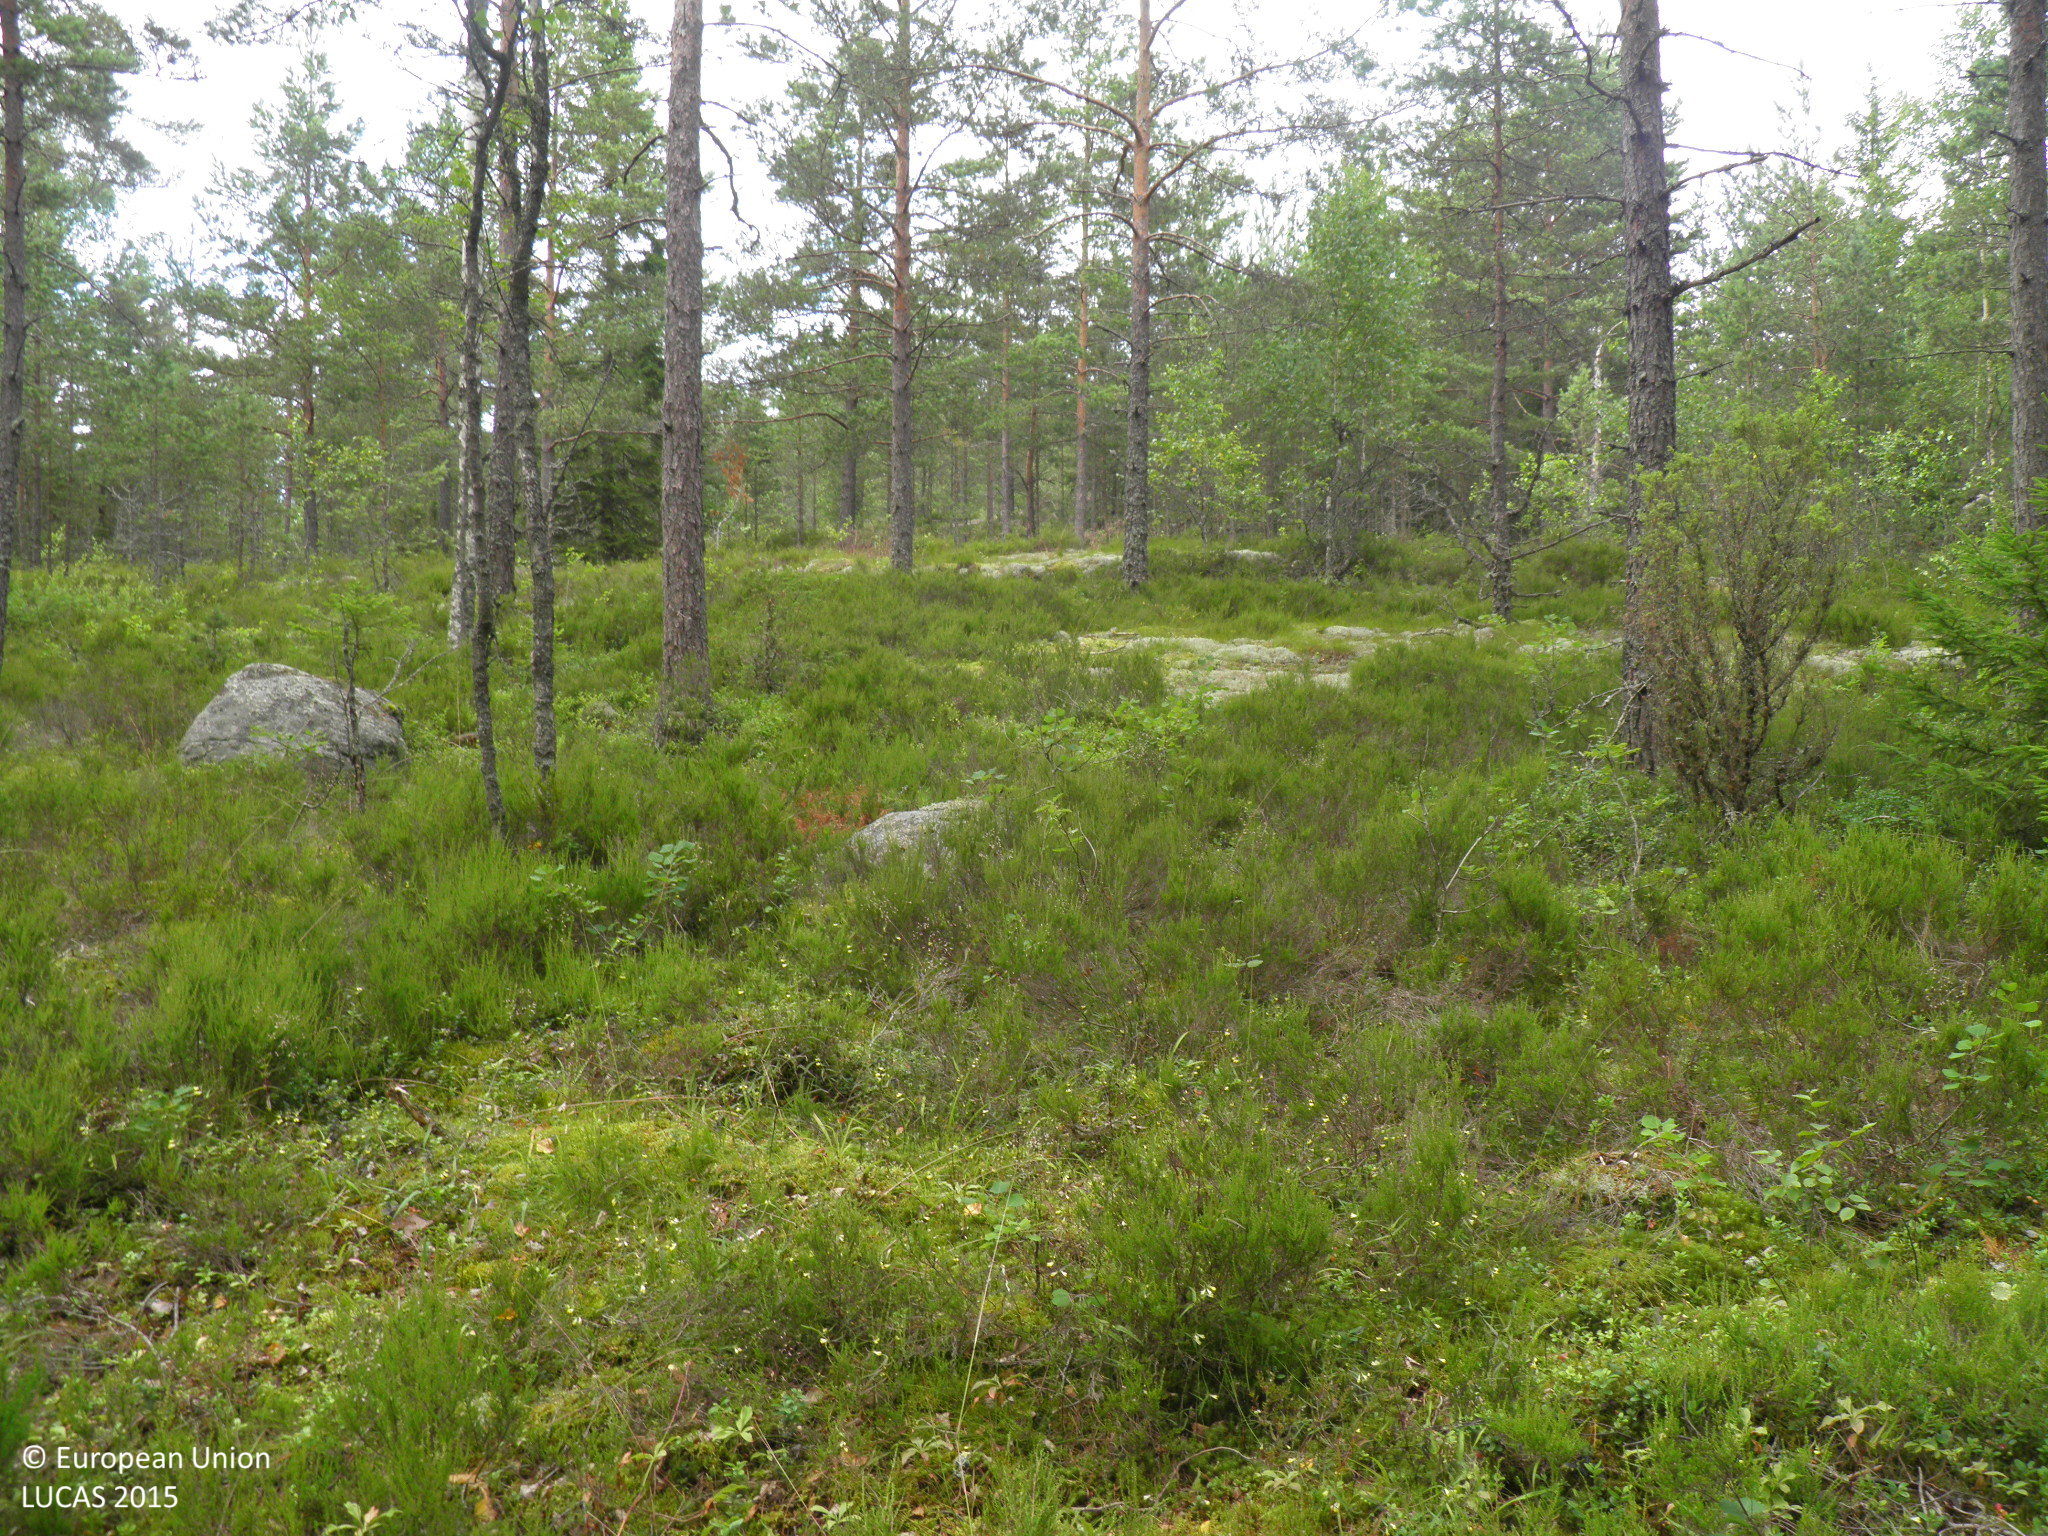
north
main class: Woodland
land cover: Pine dominated coniferous woodland
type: hemiboreal forest and nemoral coniferous forest and mixed broadleaved-coniferous forest
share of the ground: 25 - 50 %
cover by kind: shrubs 50 %, coniferous forest trees 25 %, herbaceous plants 20 %, broadleaved forest trees 5 %
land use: Forestry
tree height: > 5 m
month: July
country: FI
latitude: 60.0487
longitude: 22.6266
